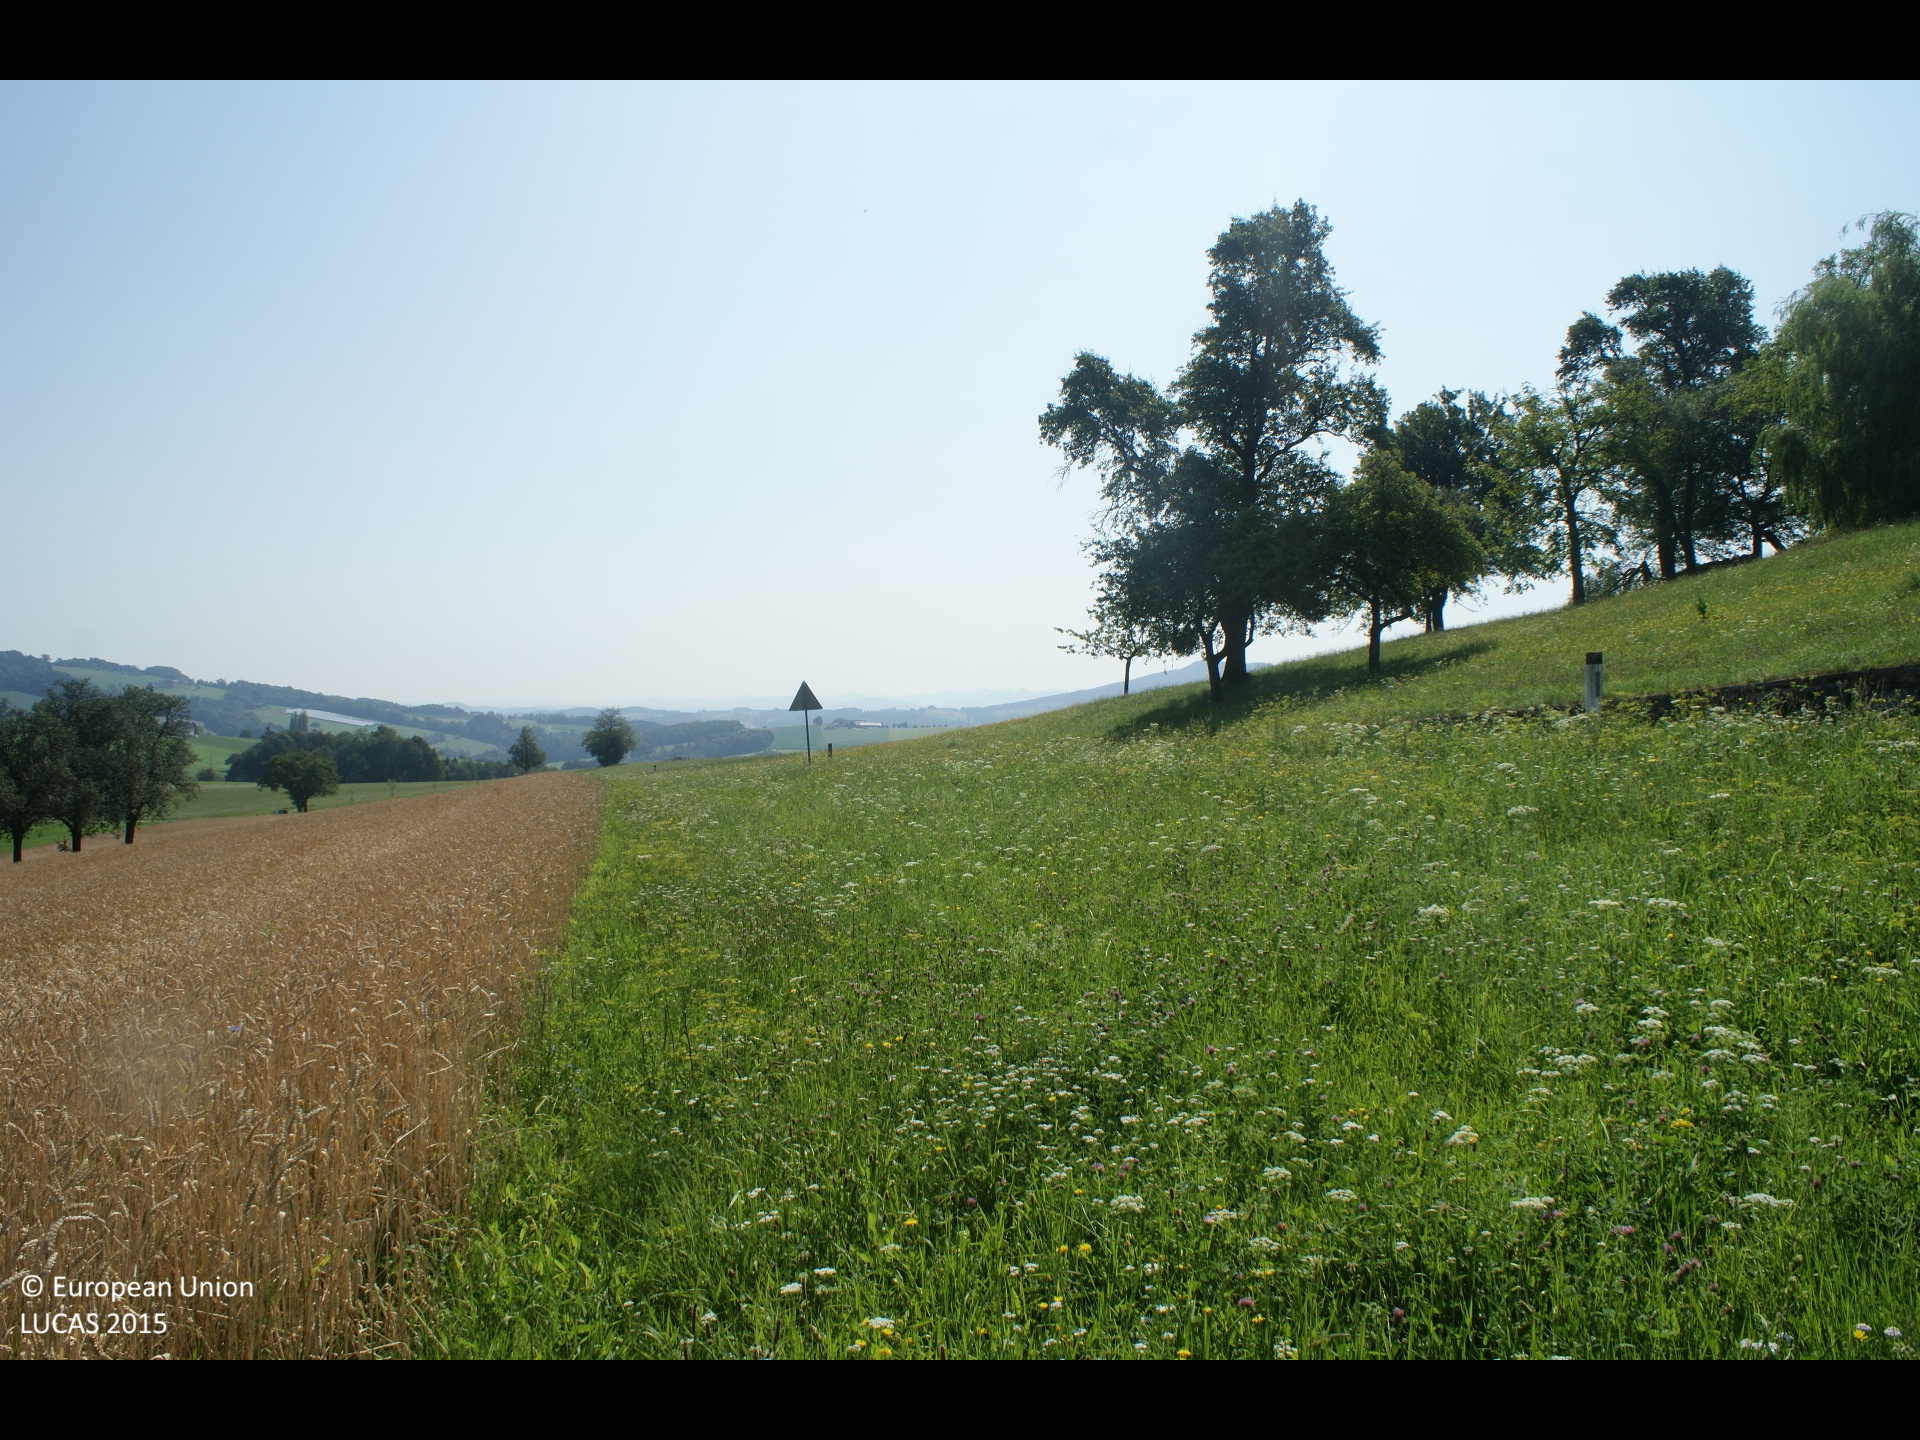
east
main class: Cropland
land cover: Common wheat
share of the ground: > 75 %
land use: Agriculture (excluding fallow land and kitchen gardens)
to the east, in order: Common wheat; Tracks; Barley; Common wheat; Grass margins; Paved roads, cycling and walking lanes; Grassland without tree/shrub cover
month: July
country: AT
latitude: 48.0570
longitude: 14.9787
